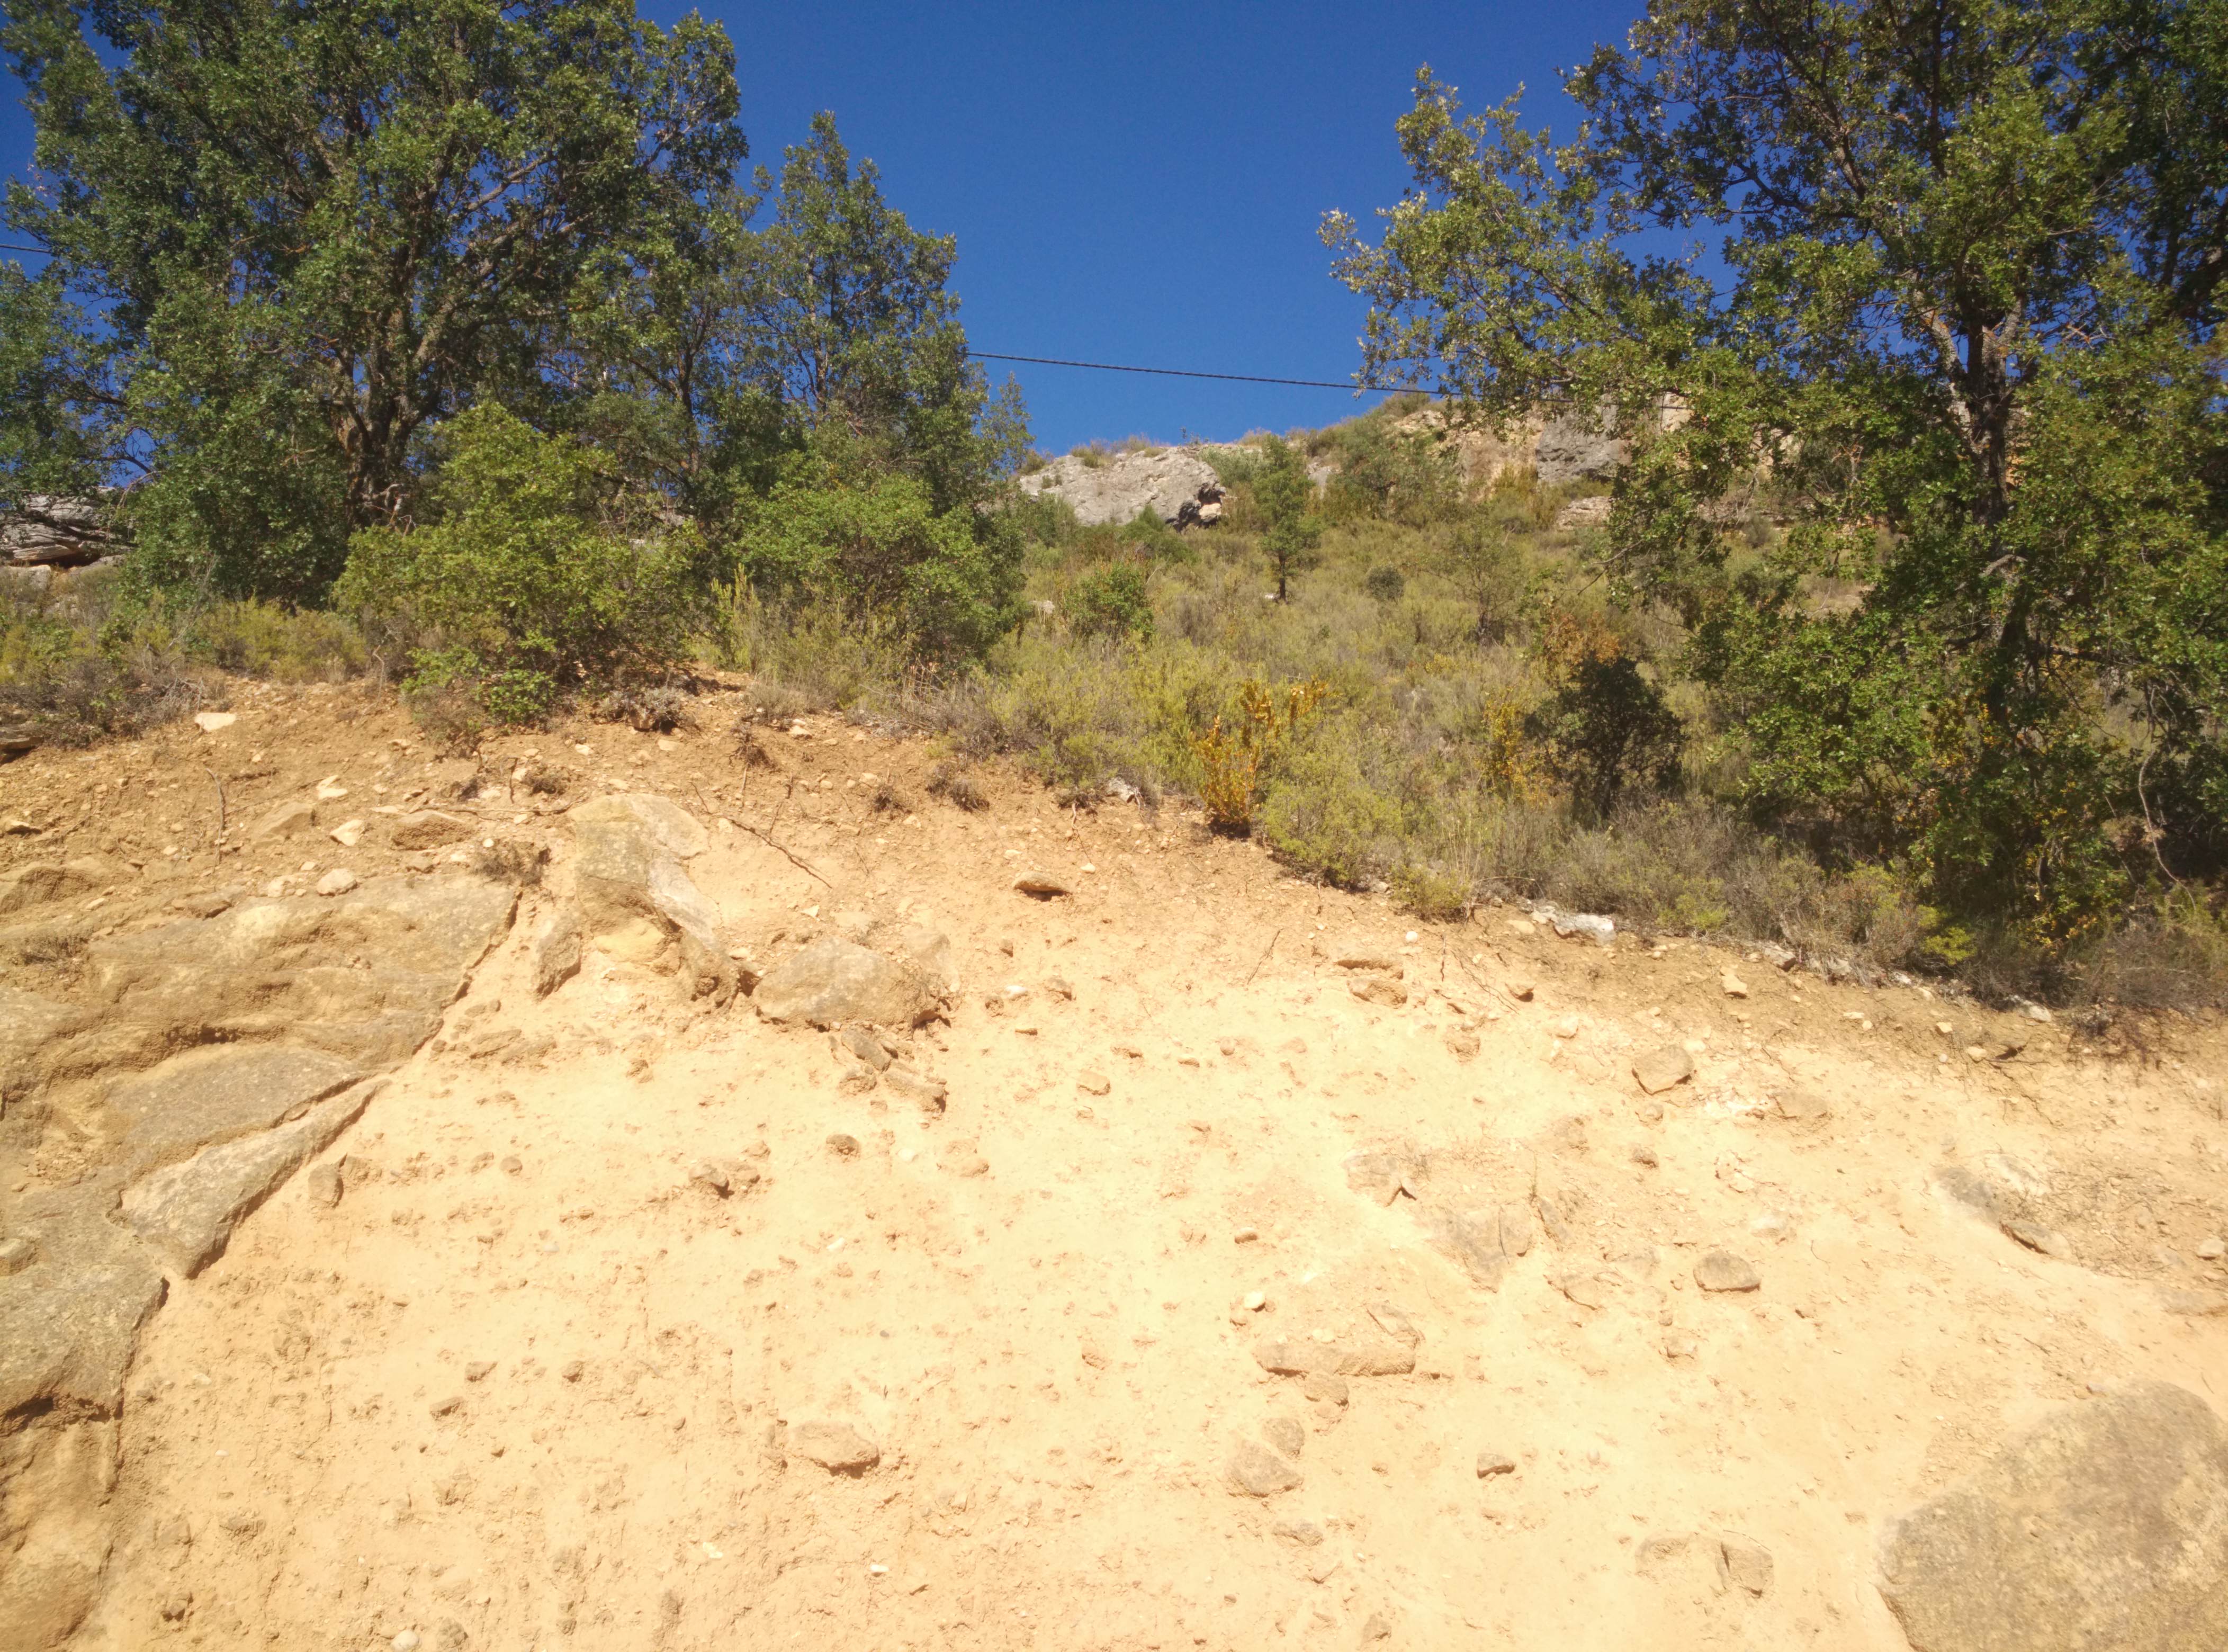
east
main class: Shrubland
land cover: Shrubland without tree cover
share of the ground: 50 - 75 %
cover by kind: shrubs 50 %, unconsolidated bare surface 40 %, herbaceous plants 10 %
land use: Semi-natural and natural areas not in use
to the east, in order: Shrubland without tree cover; Rocks and stones; Shrubland without tree cover; Rocks and stones; Shrubland without tree cover; Rocks and stones; Shrubland without tree cover
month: July
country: ES
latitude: 40.6968
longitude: -2.5838
